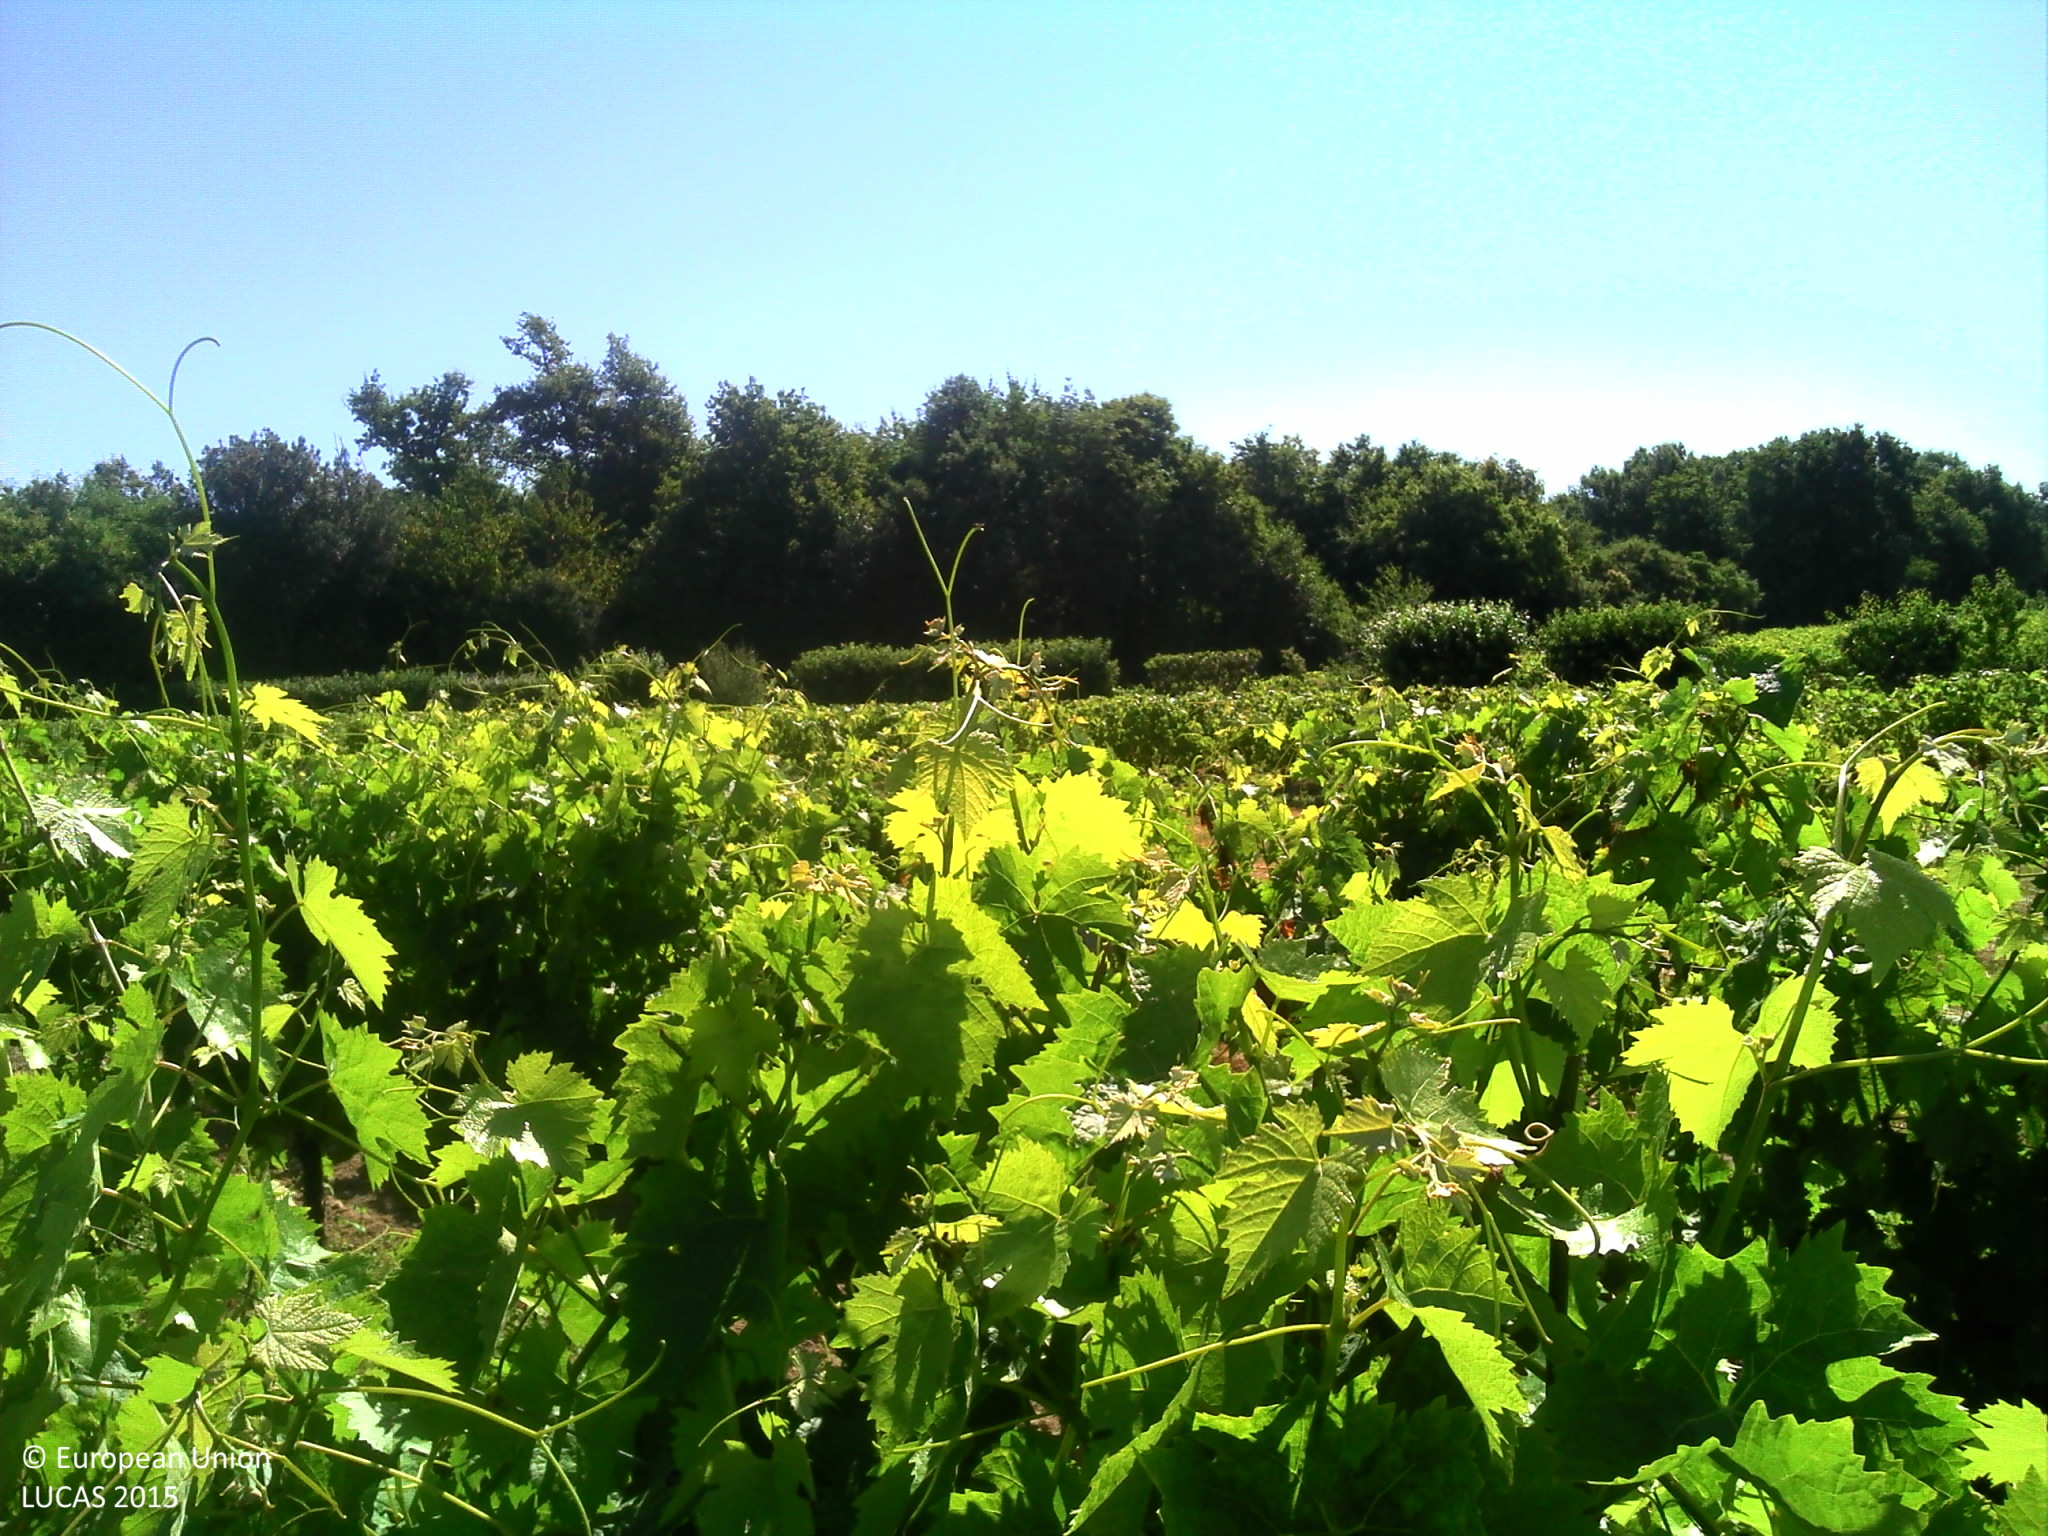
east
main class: Cropland
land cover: Vineyards
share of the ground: 25 - 50 %
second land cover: Other bare soil
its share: > 75 %
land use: Agriculture (excluding fallow land and kitchen gardens)
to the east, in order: Vineyards; Other bare soil; Vineyards; Apple fruit; Fences; Grassland with sparse tree/shrub cover; Fences; Tracks; Broadleaved woodland
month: June
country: FR
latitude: 45.6377
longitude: -0.8146
